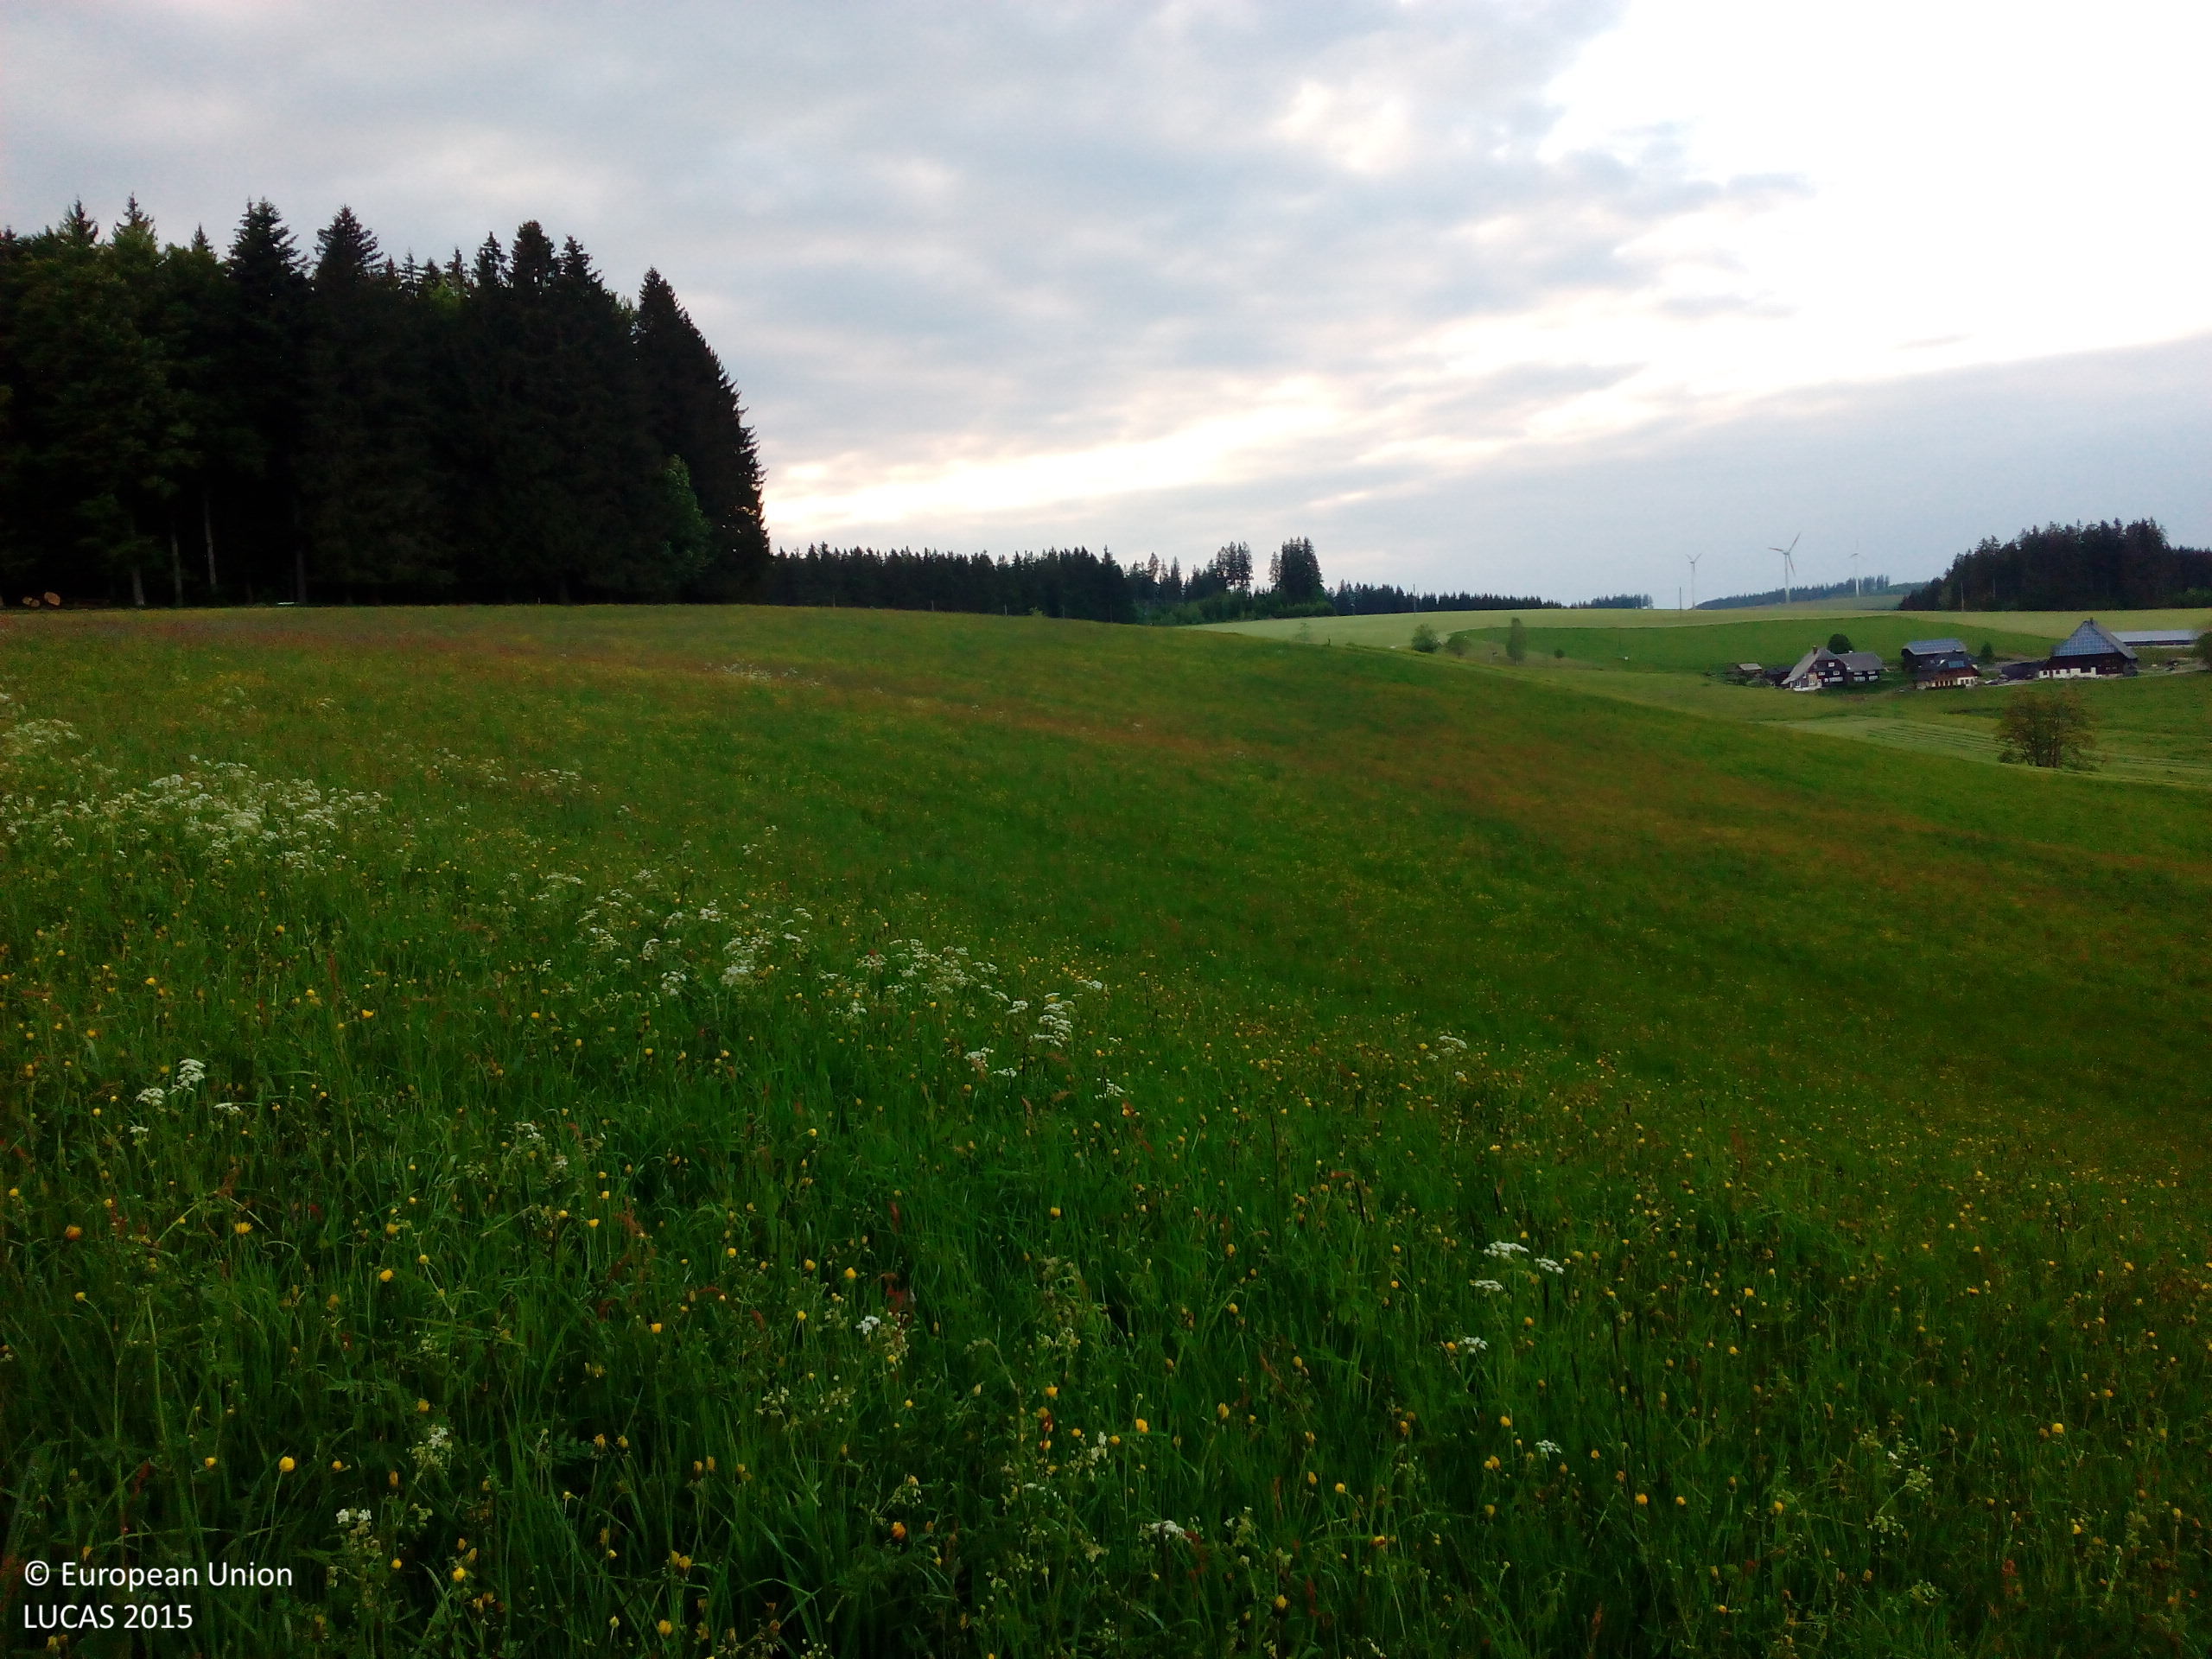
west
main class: Grassland
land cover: Grassland without tree/shrub cover
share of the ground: > 75 %
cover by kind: herbaceous plants 100 %
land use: Agriculture (excluding fallow land and kitchen gardens)
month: May
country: DE
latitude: 48.0278
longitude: 8.1371
